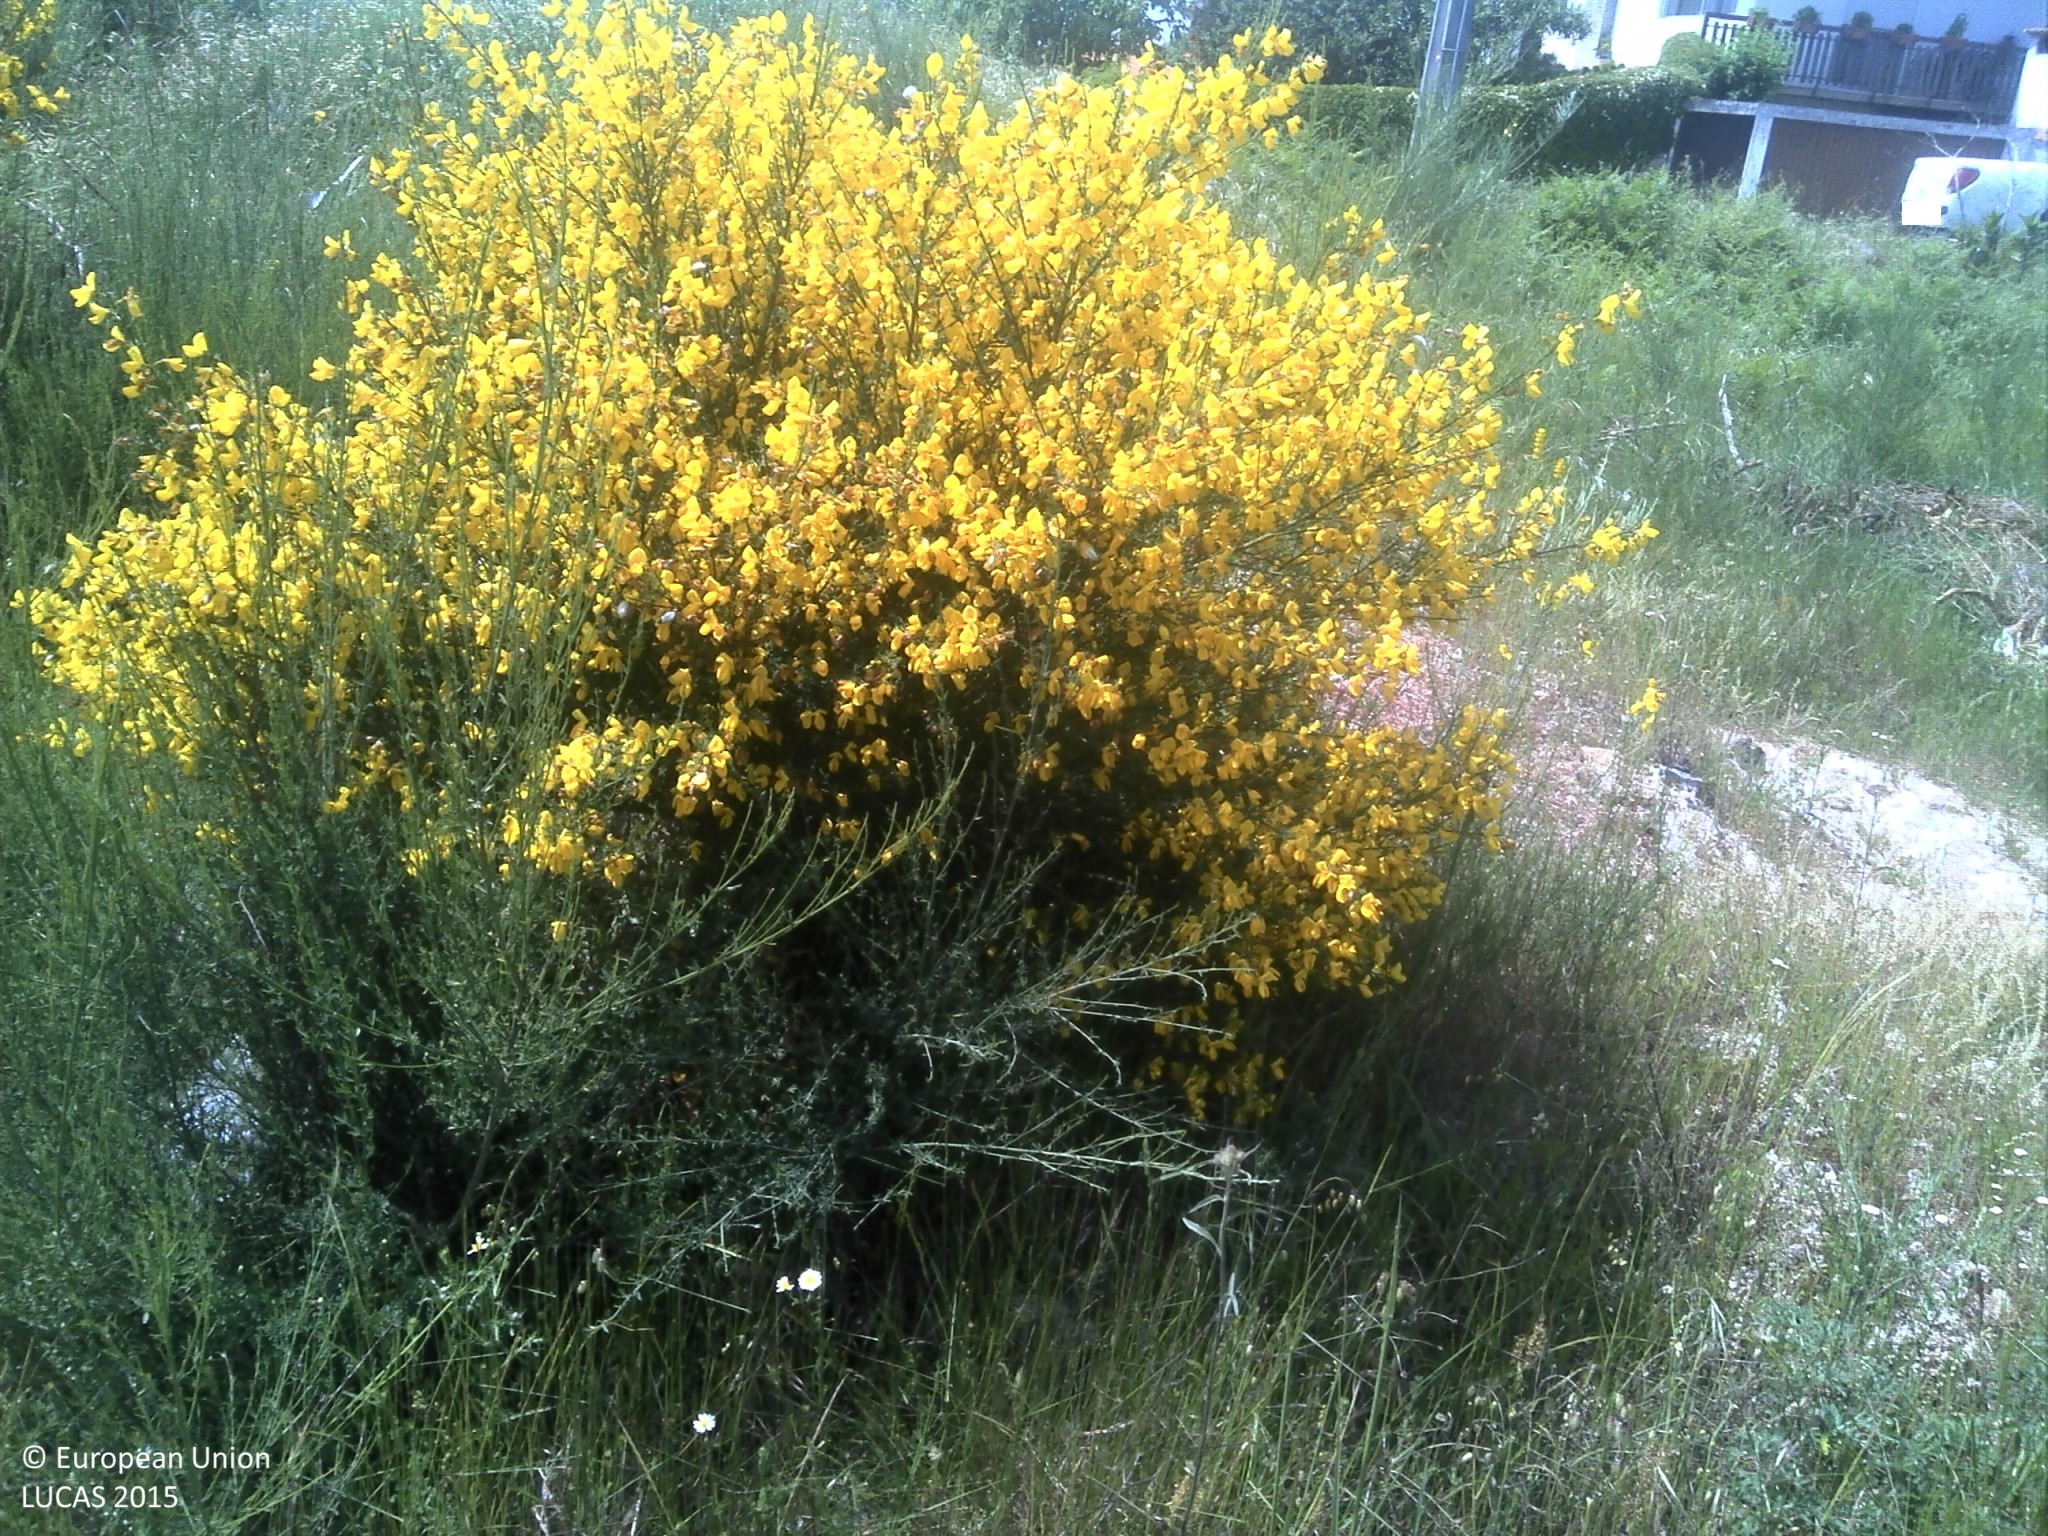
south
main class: Shrubland
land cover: Shrubland without tree cover
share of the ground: 25 - 50 %
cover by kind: shrubs 65 %, herbaceous plants 20 %, consolidated bare surface 15 %
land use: Abandoned areas
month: May
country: PT
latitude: 40.5898
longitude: -7.7598
